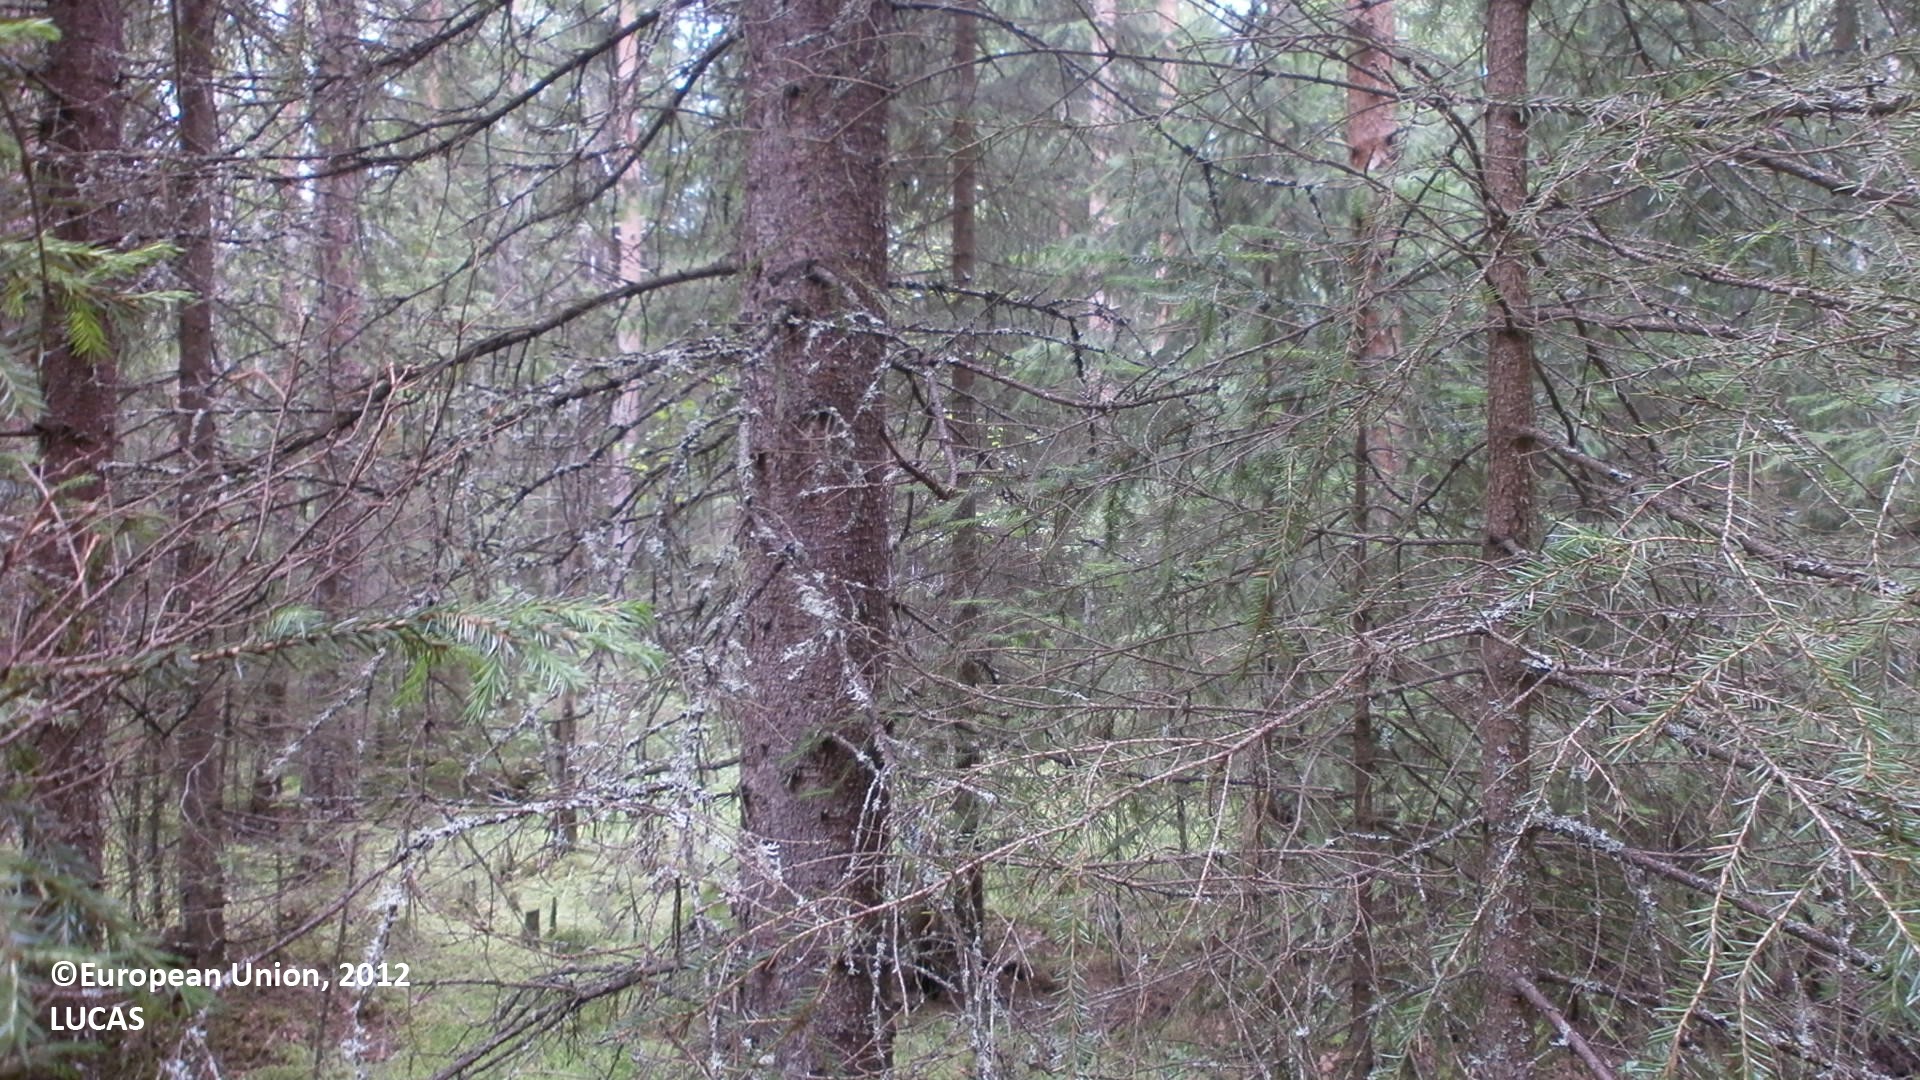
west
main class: Woodland
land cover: Spruce dominated mixed woodland
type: boreal forest
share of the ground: > 75 %
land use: Forestry
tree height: > 5 m
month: July
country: FI
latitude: 64.2137
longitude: 24.2215
